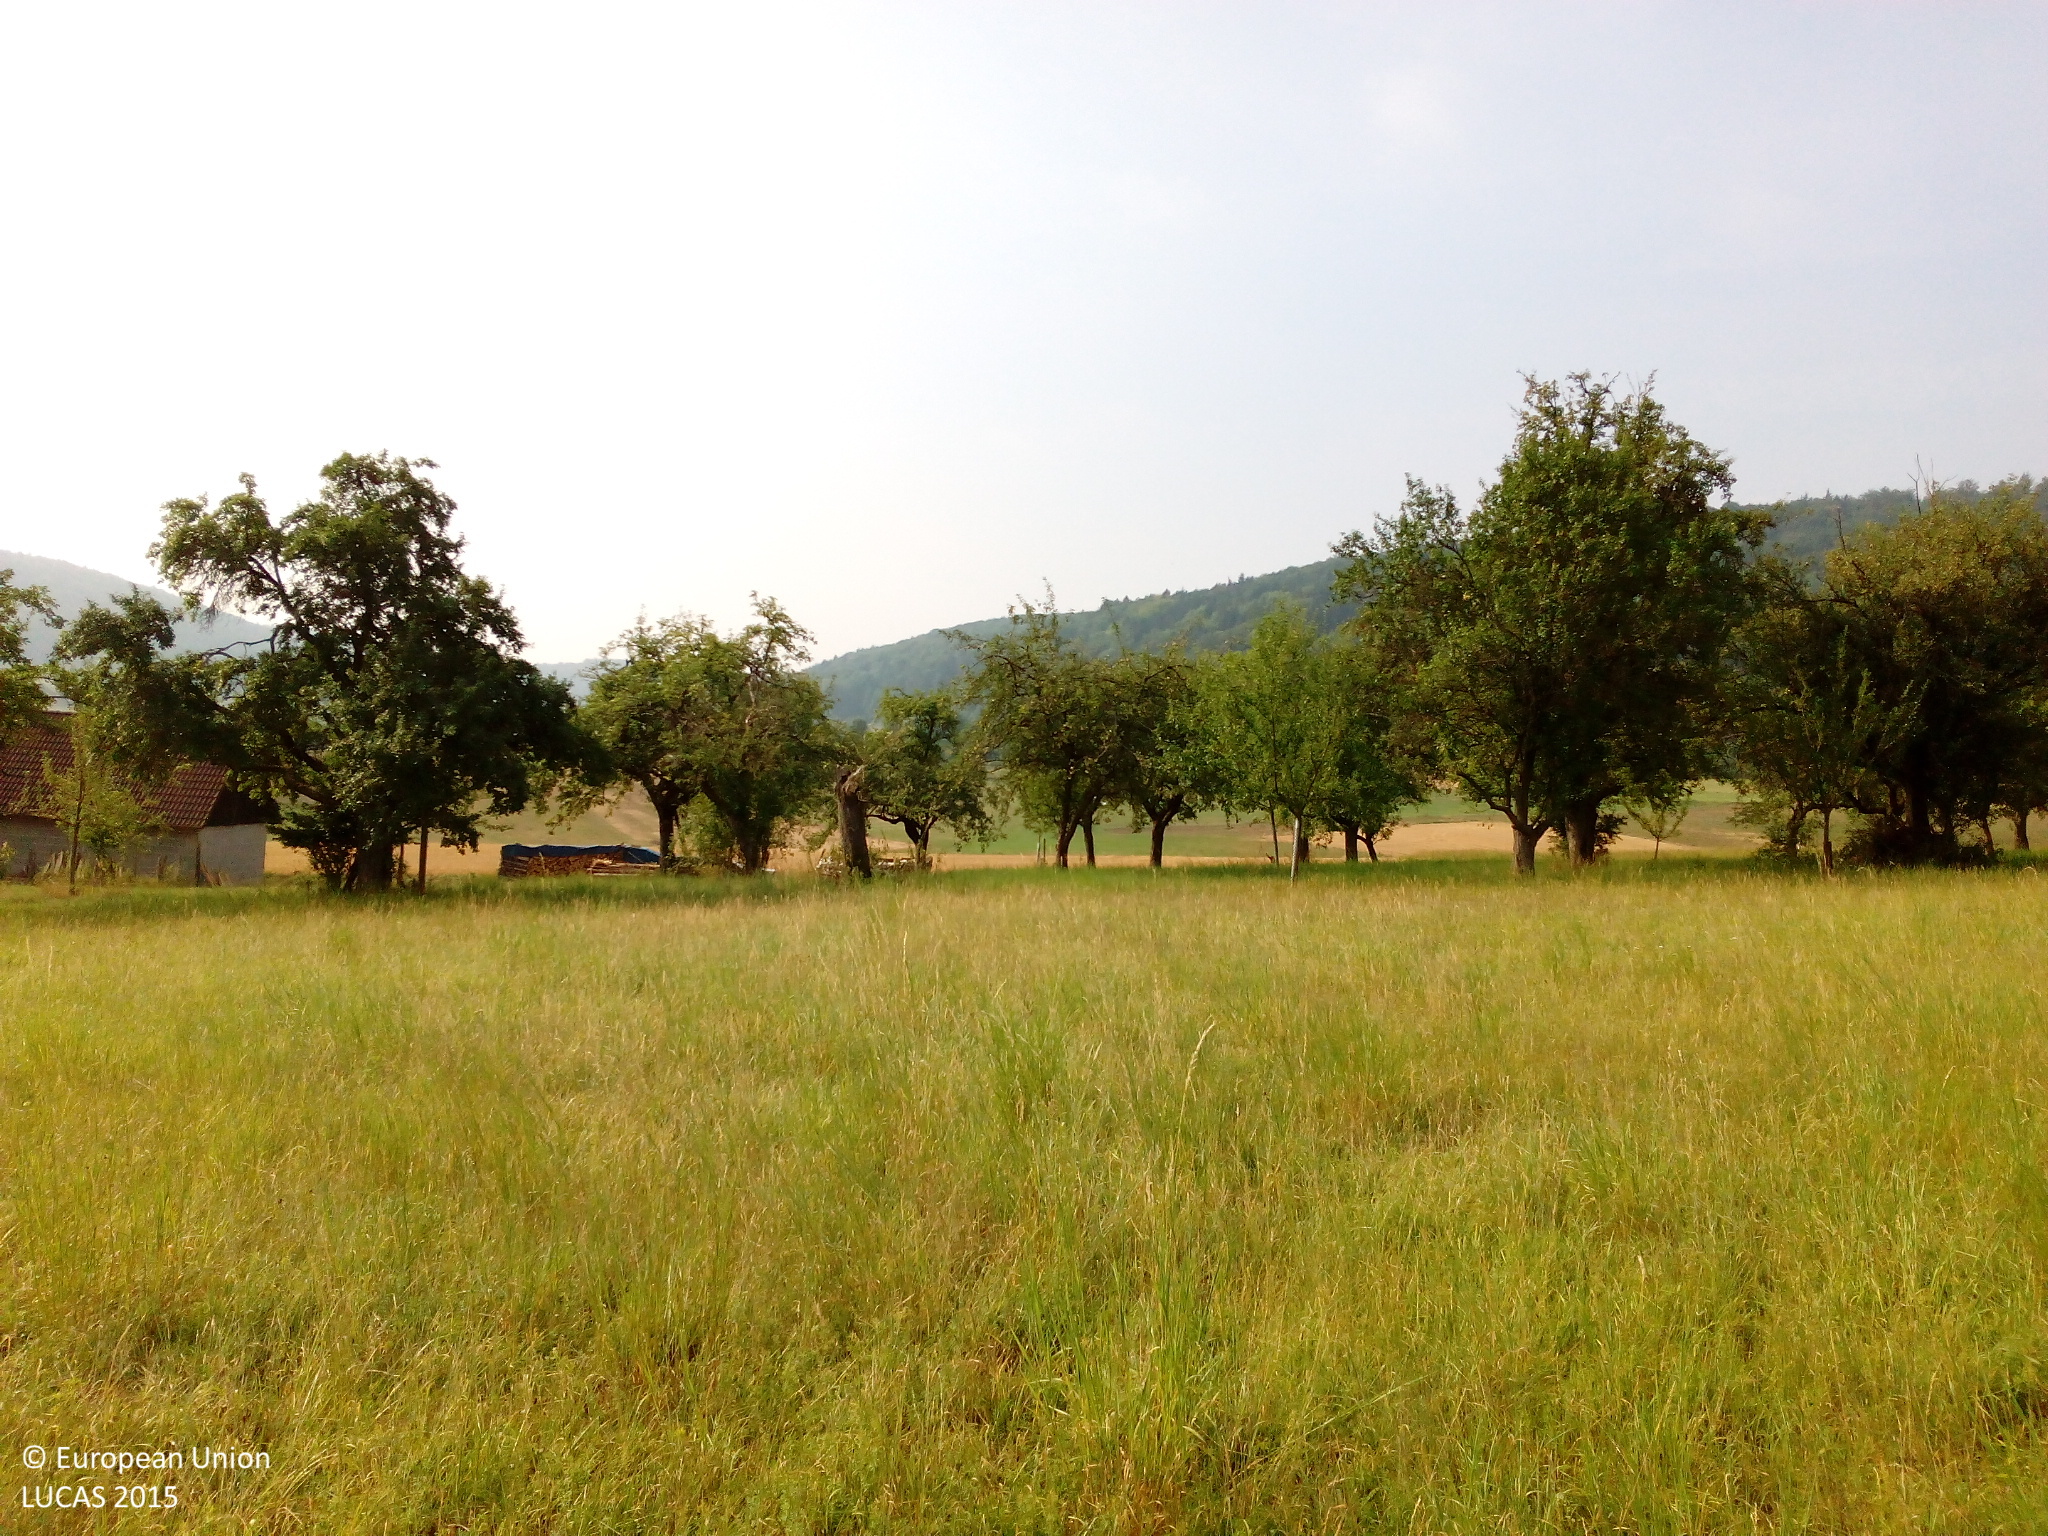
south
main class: Grassland
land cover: Grassland without tree/shrub cover
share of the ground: > 75 %
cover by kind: herbaceous plants 95 %
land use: Agriculture (excluding fallow land and kitchen gardens)
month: August
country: DE
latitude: 49.4732
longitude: 11.4762
